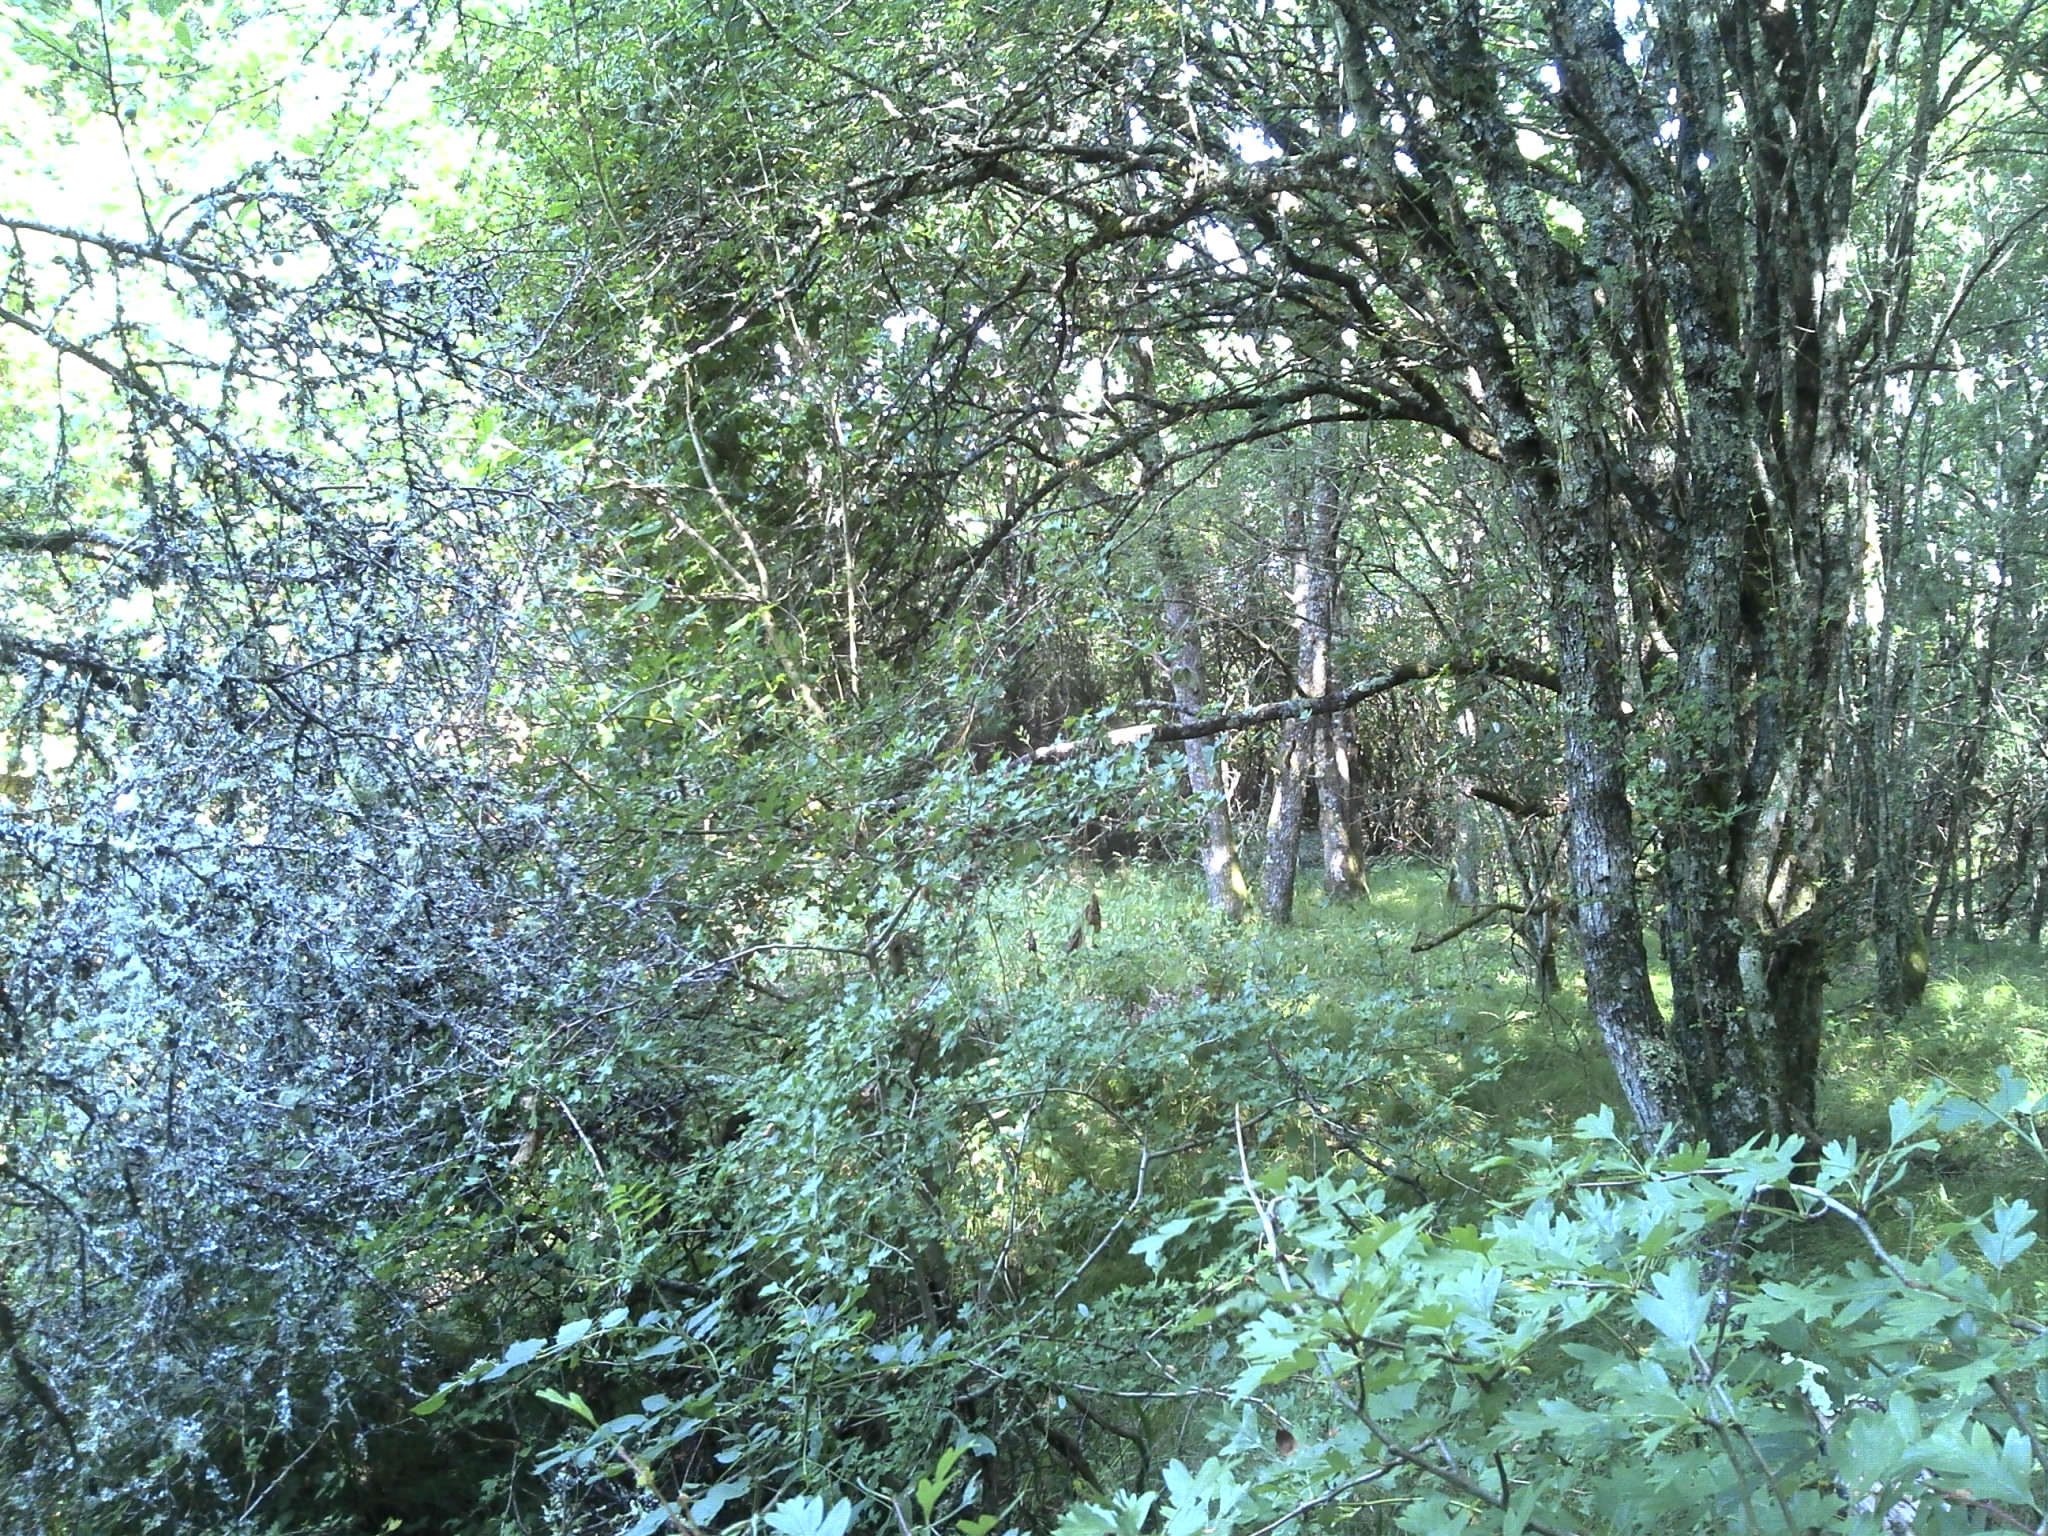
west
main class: Woodland
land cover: Broadleaved woodland
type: mesophytic deciduous forest
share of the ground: > 75 %
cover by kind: broadleaved forest trees 95 %, herbaceous plants 5 %
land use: Forestry
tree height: > 5 m
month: July
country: FR
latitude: 46.6867
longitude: 1.5560
